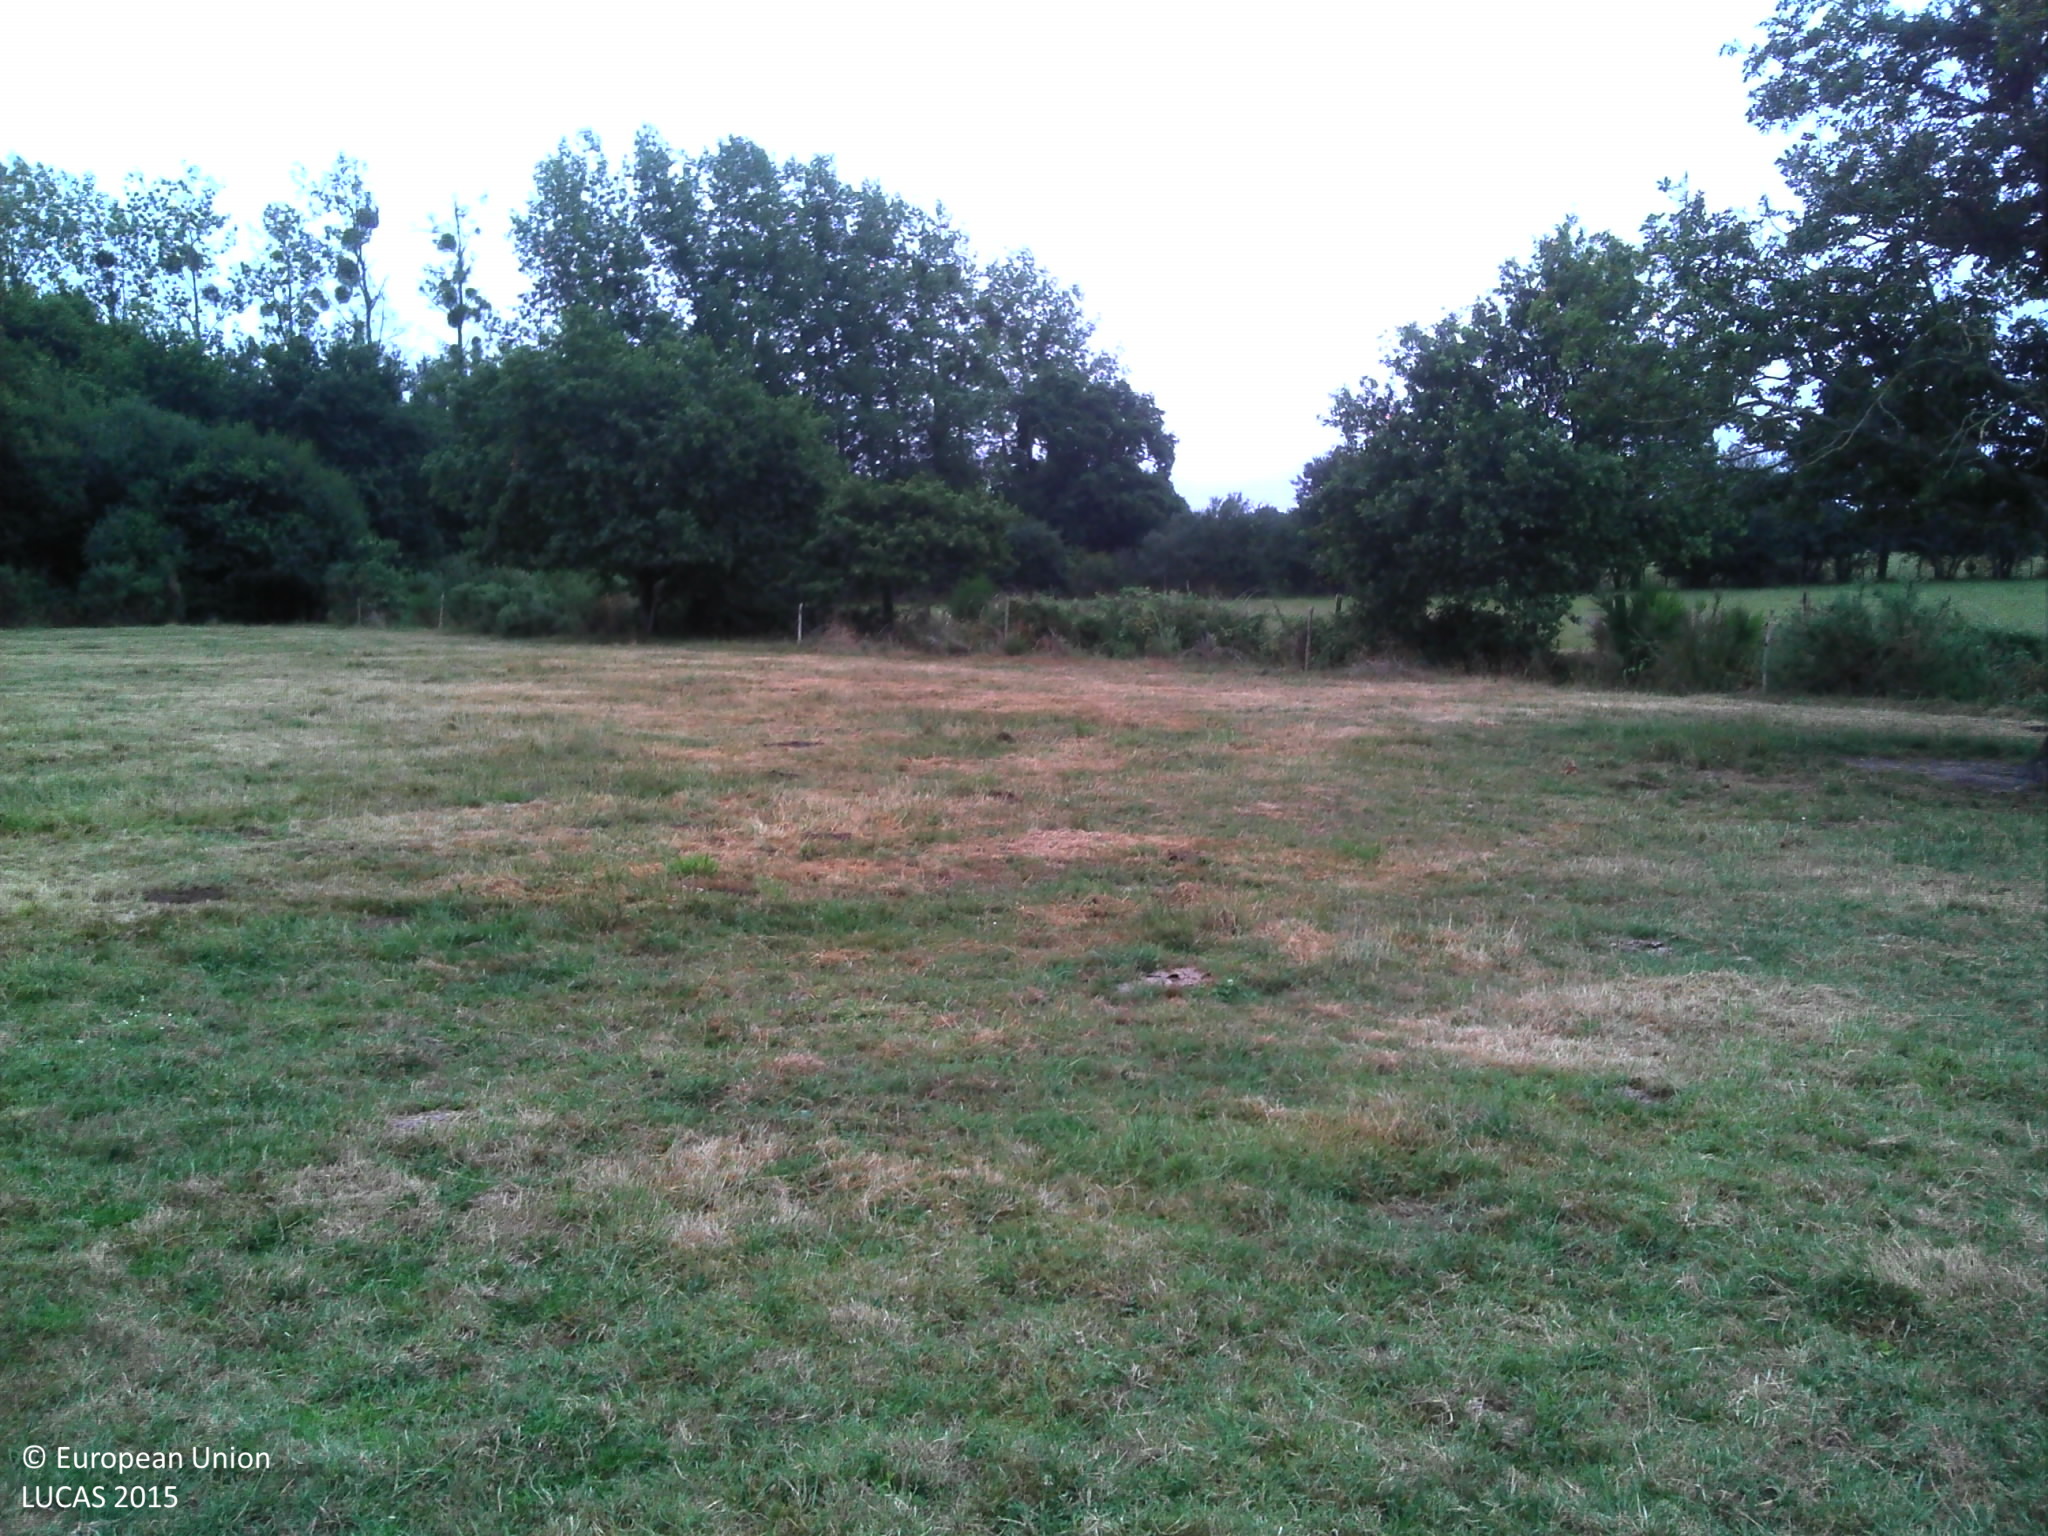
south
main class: Cropland
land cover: Temporary grasslands
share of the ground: > 75 %
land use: Agriculture (excluding fallow land and kitchen gardens)
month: July
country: FR
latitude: 47.4826
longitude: -1.9259
